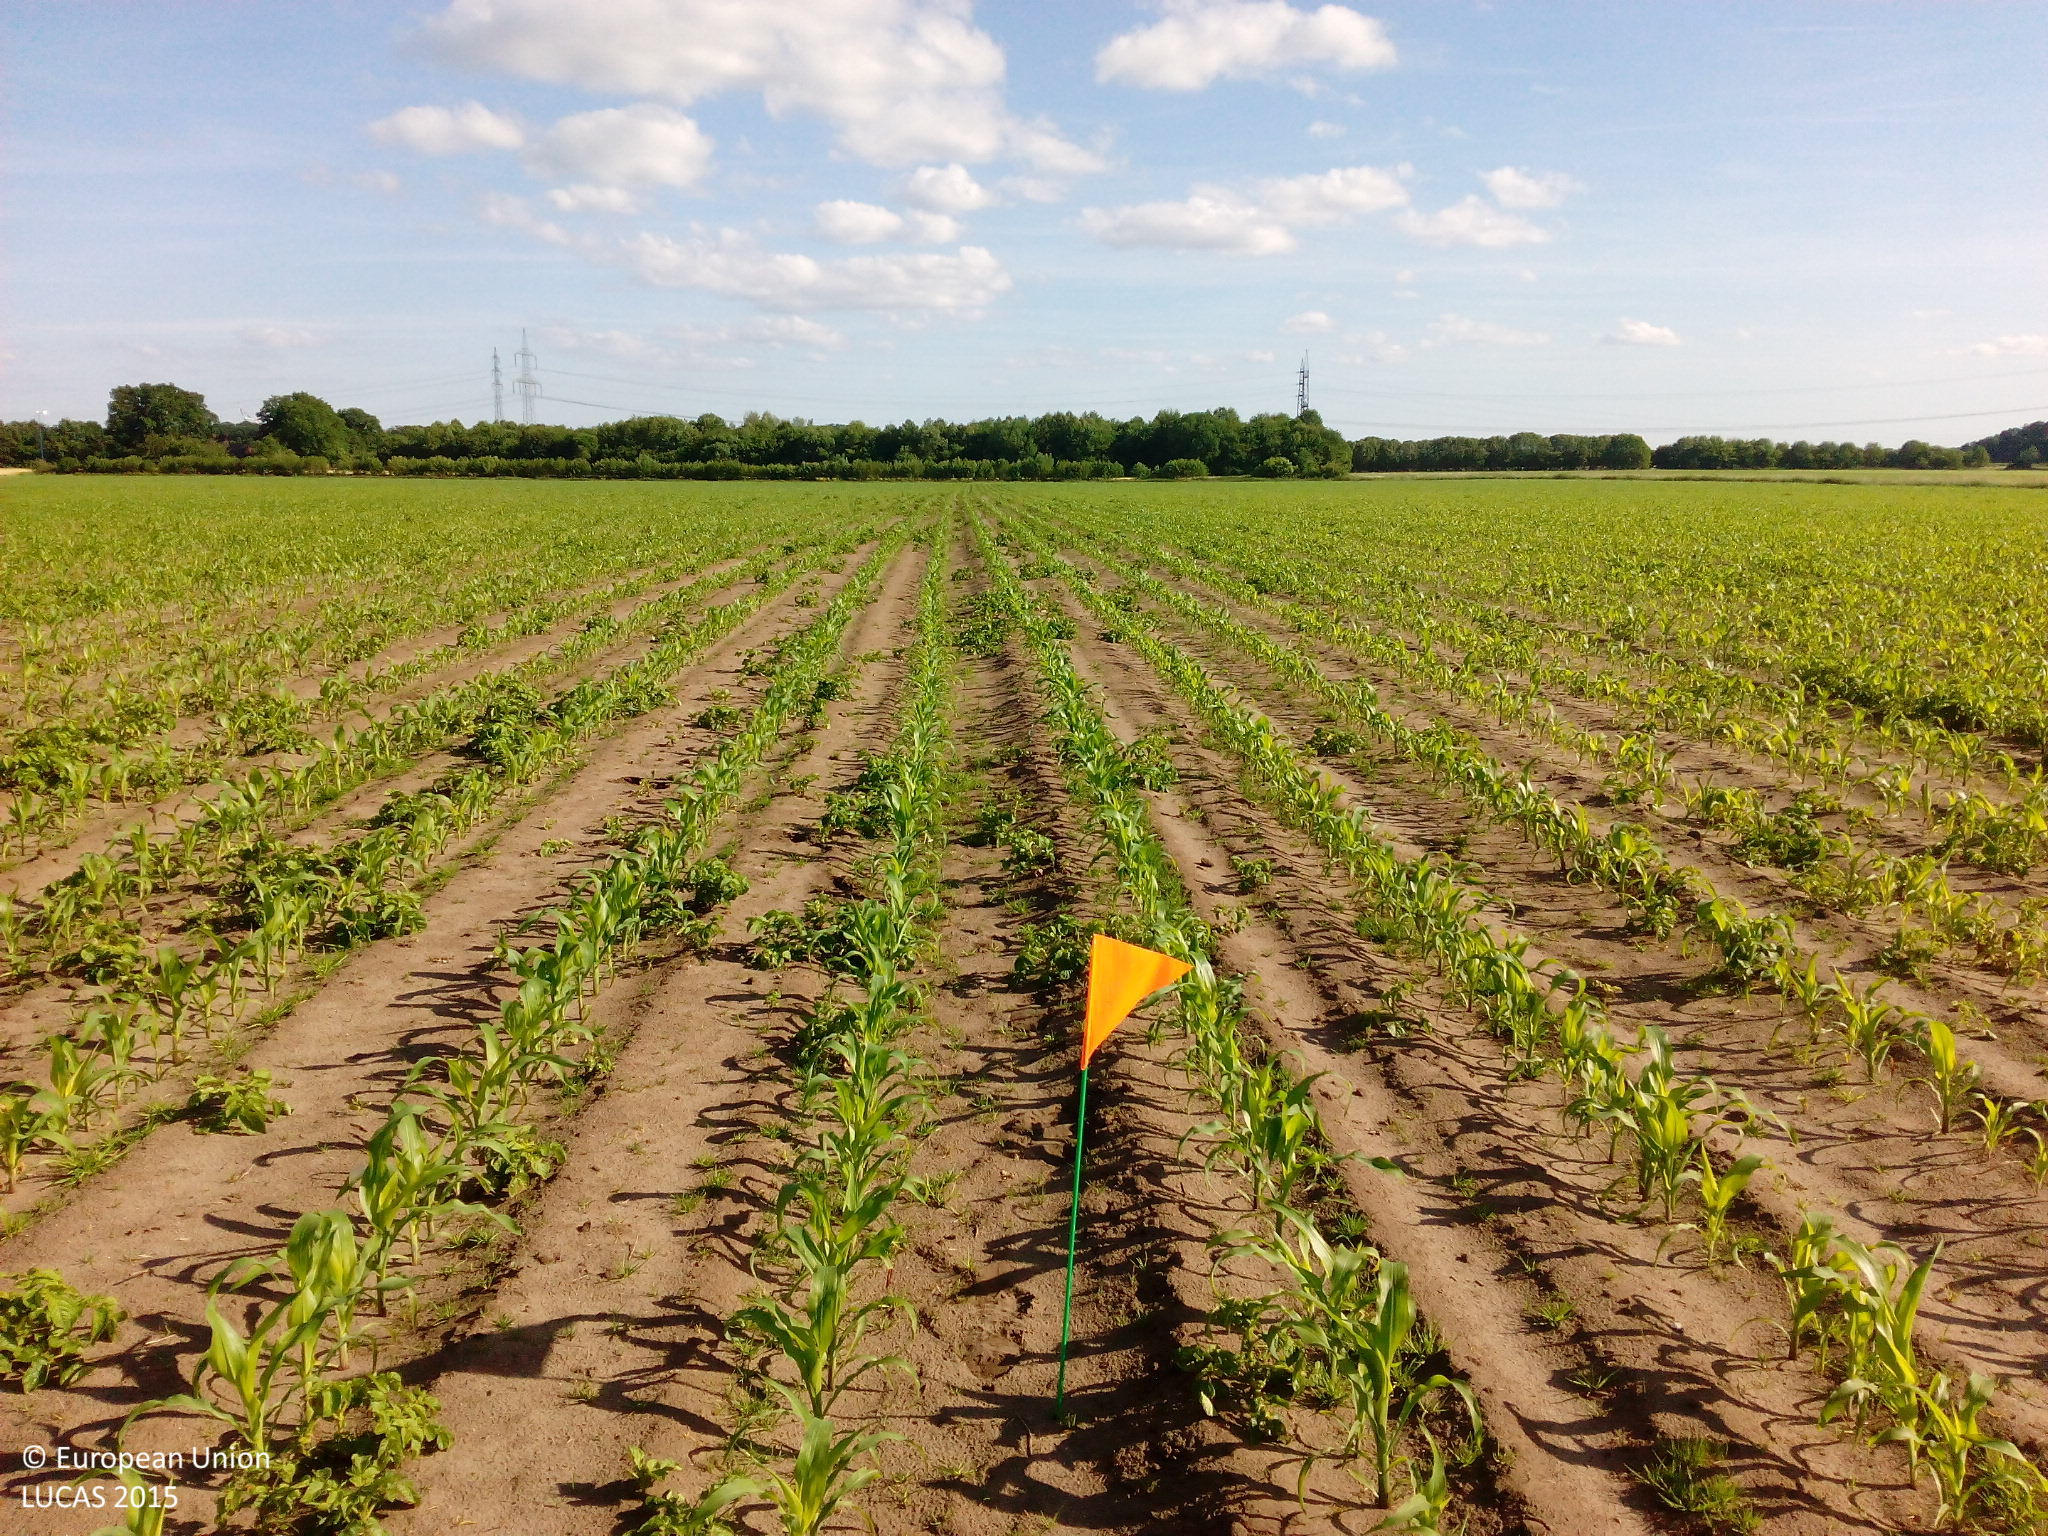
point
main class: Cropland
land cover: Maize
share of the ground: 10 - 25 %
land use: Agriculture (excluding fallow land and kitchen gardens)
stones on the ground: < 10 %
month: June
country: DE
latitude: 52.4754
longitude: 7.4239
